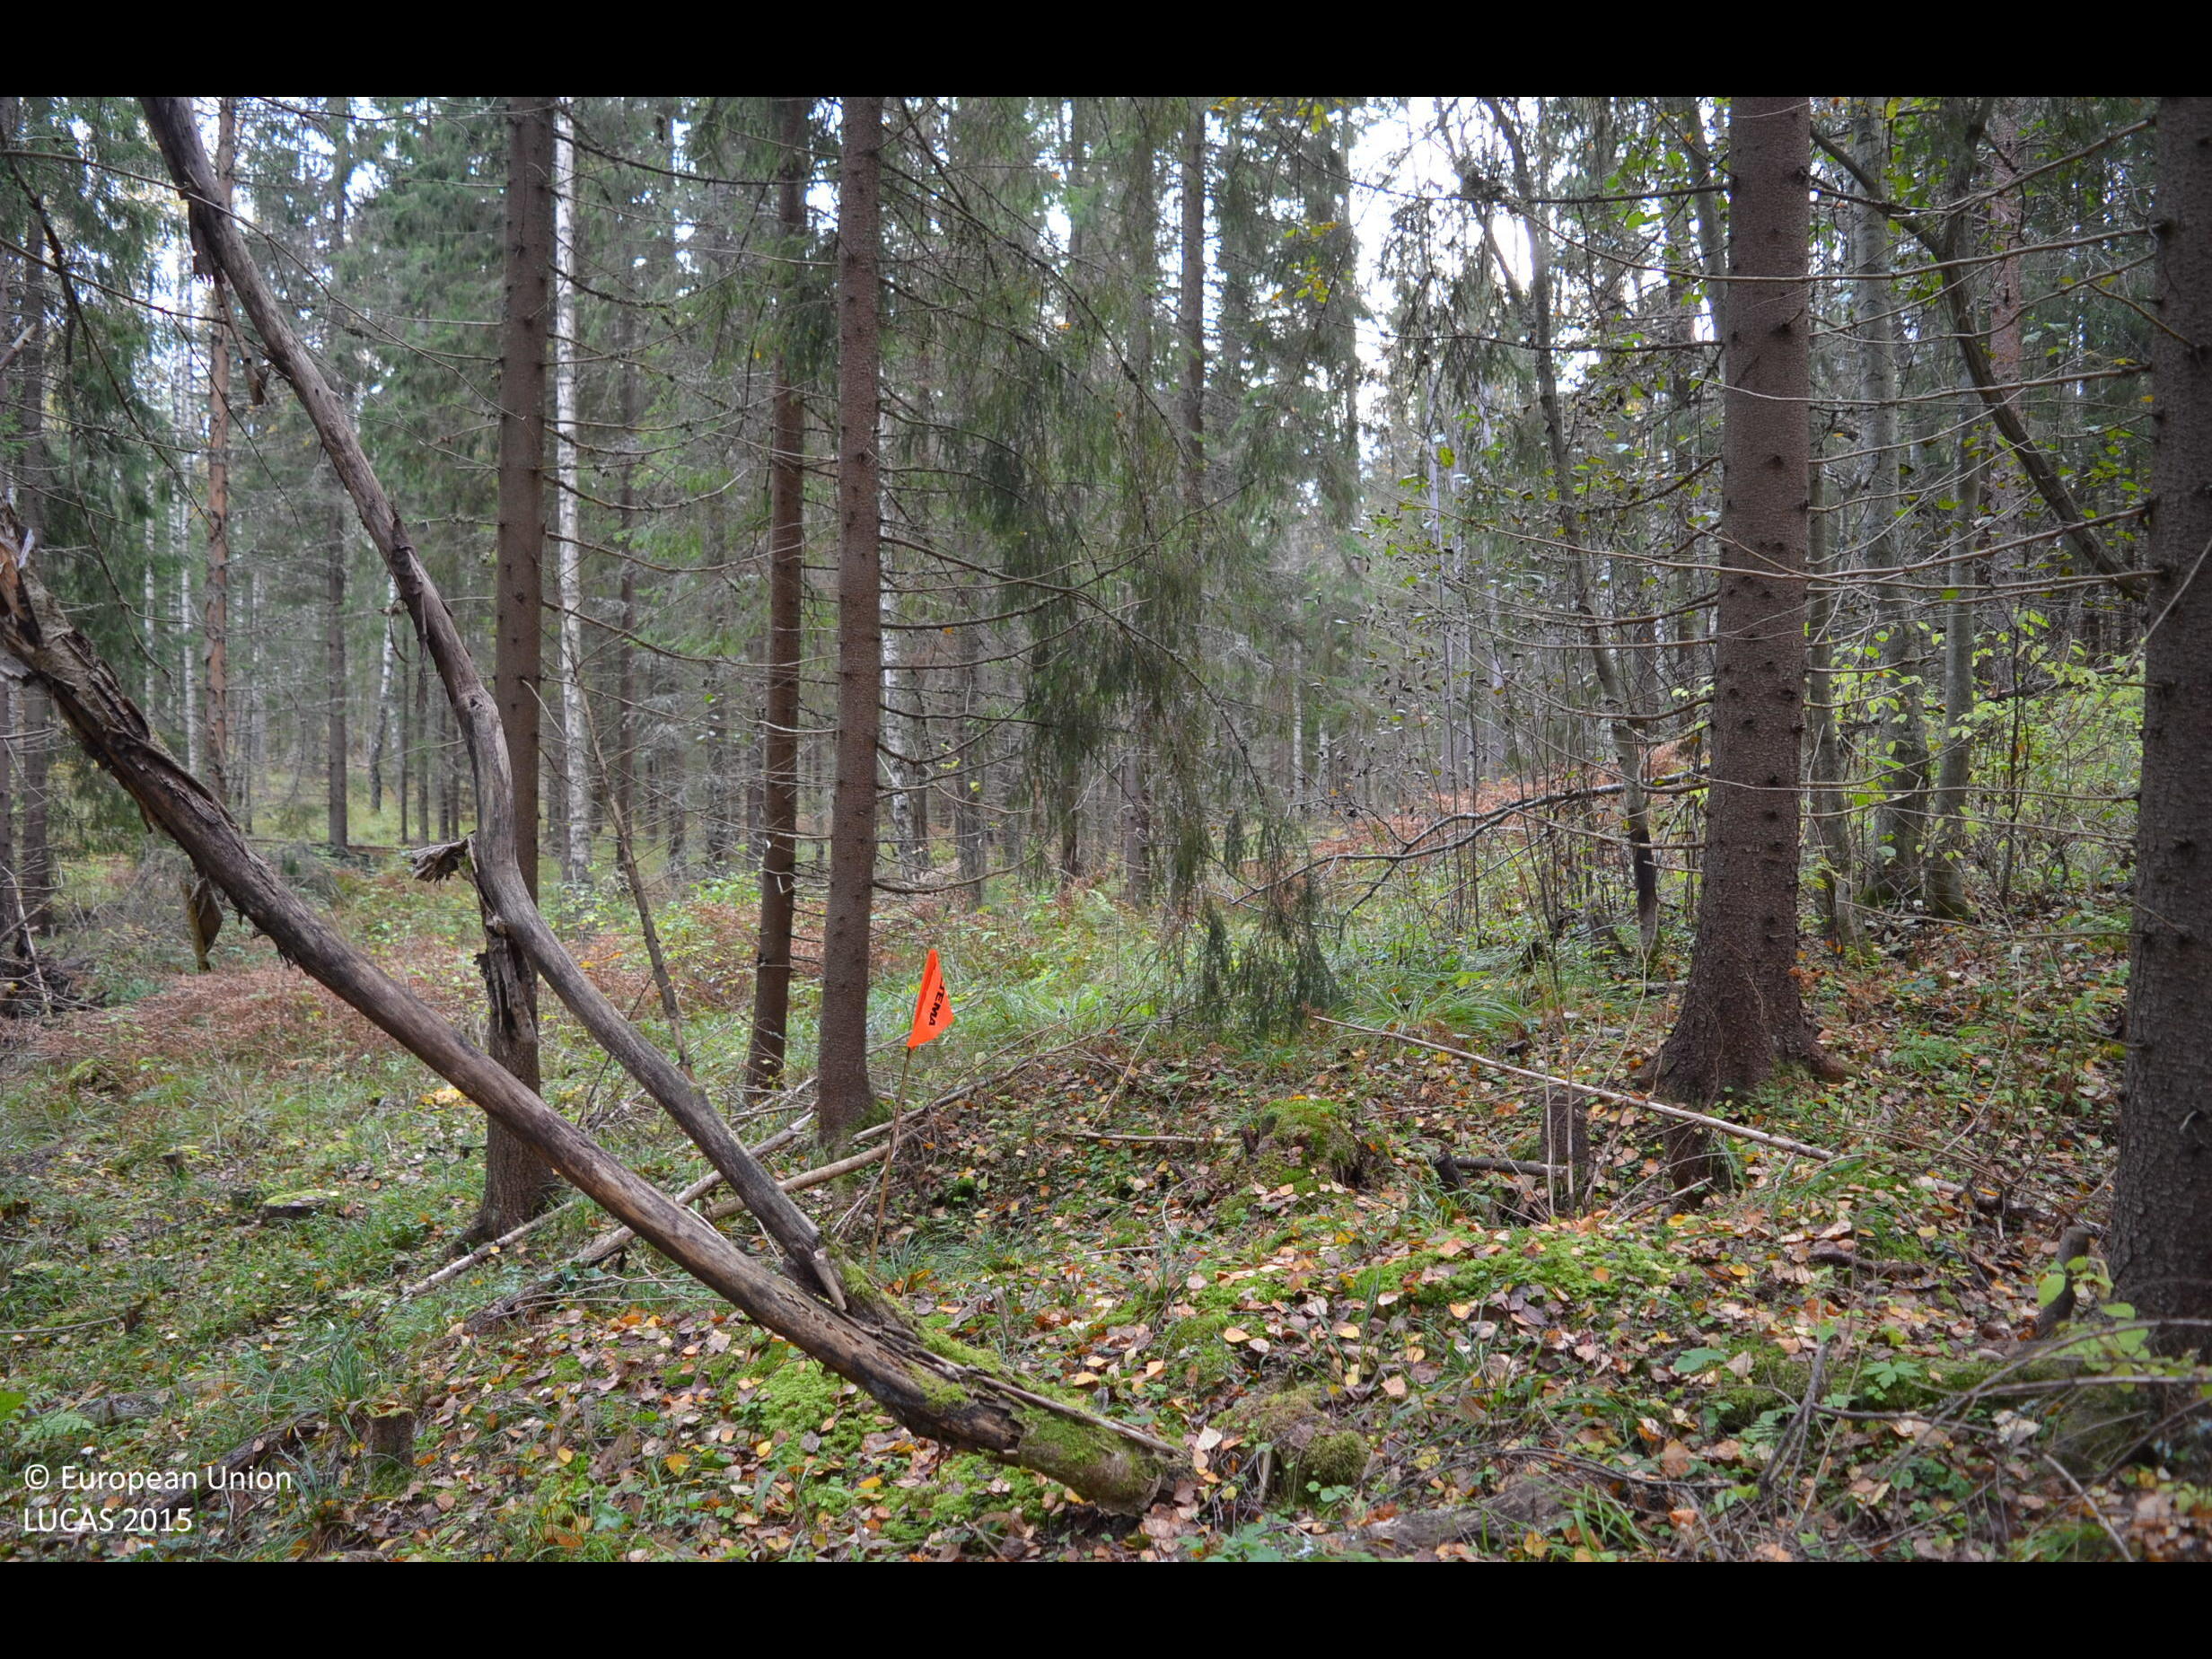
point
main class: Woodland
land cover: Spruce dominated mixed woodland
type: boreal forest
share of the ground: > 75 %
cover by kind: coniferous forest trees 55 %, broadleaved forest trees 20 %, herbaceous plants 20 %, shrubs 5 %
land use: Forestry
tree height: > 5 m
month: October
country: FI
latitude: 61.4861
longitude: 23.3151
